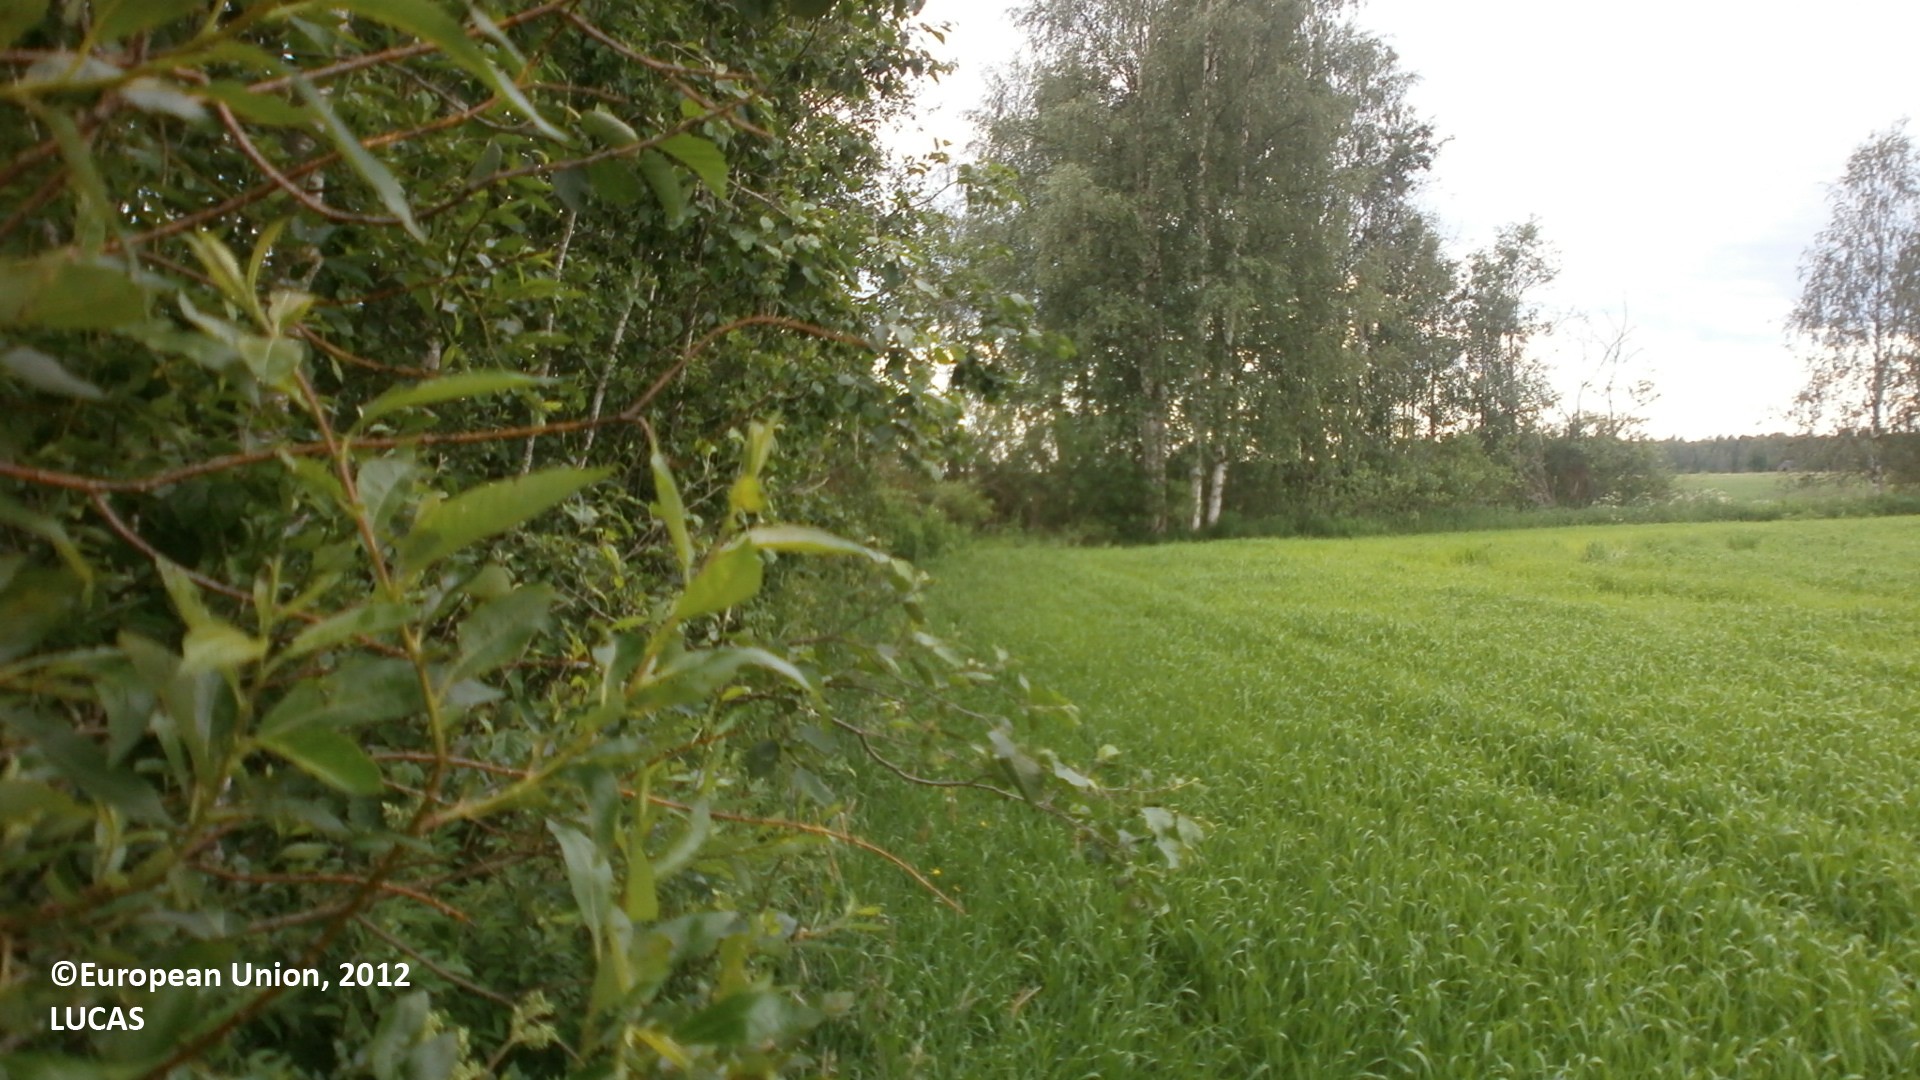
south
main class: Cropland
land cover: Barley
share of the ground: > 75 %
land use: Agriculture (excluding fallow land and kitchen gardens)
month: July
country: FI
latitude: 63.9821
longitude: 24.7297
